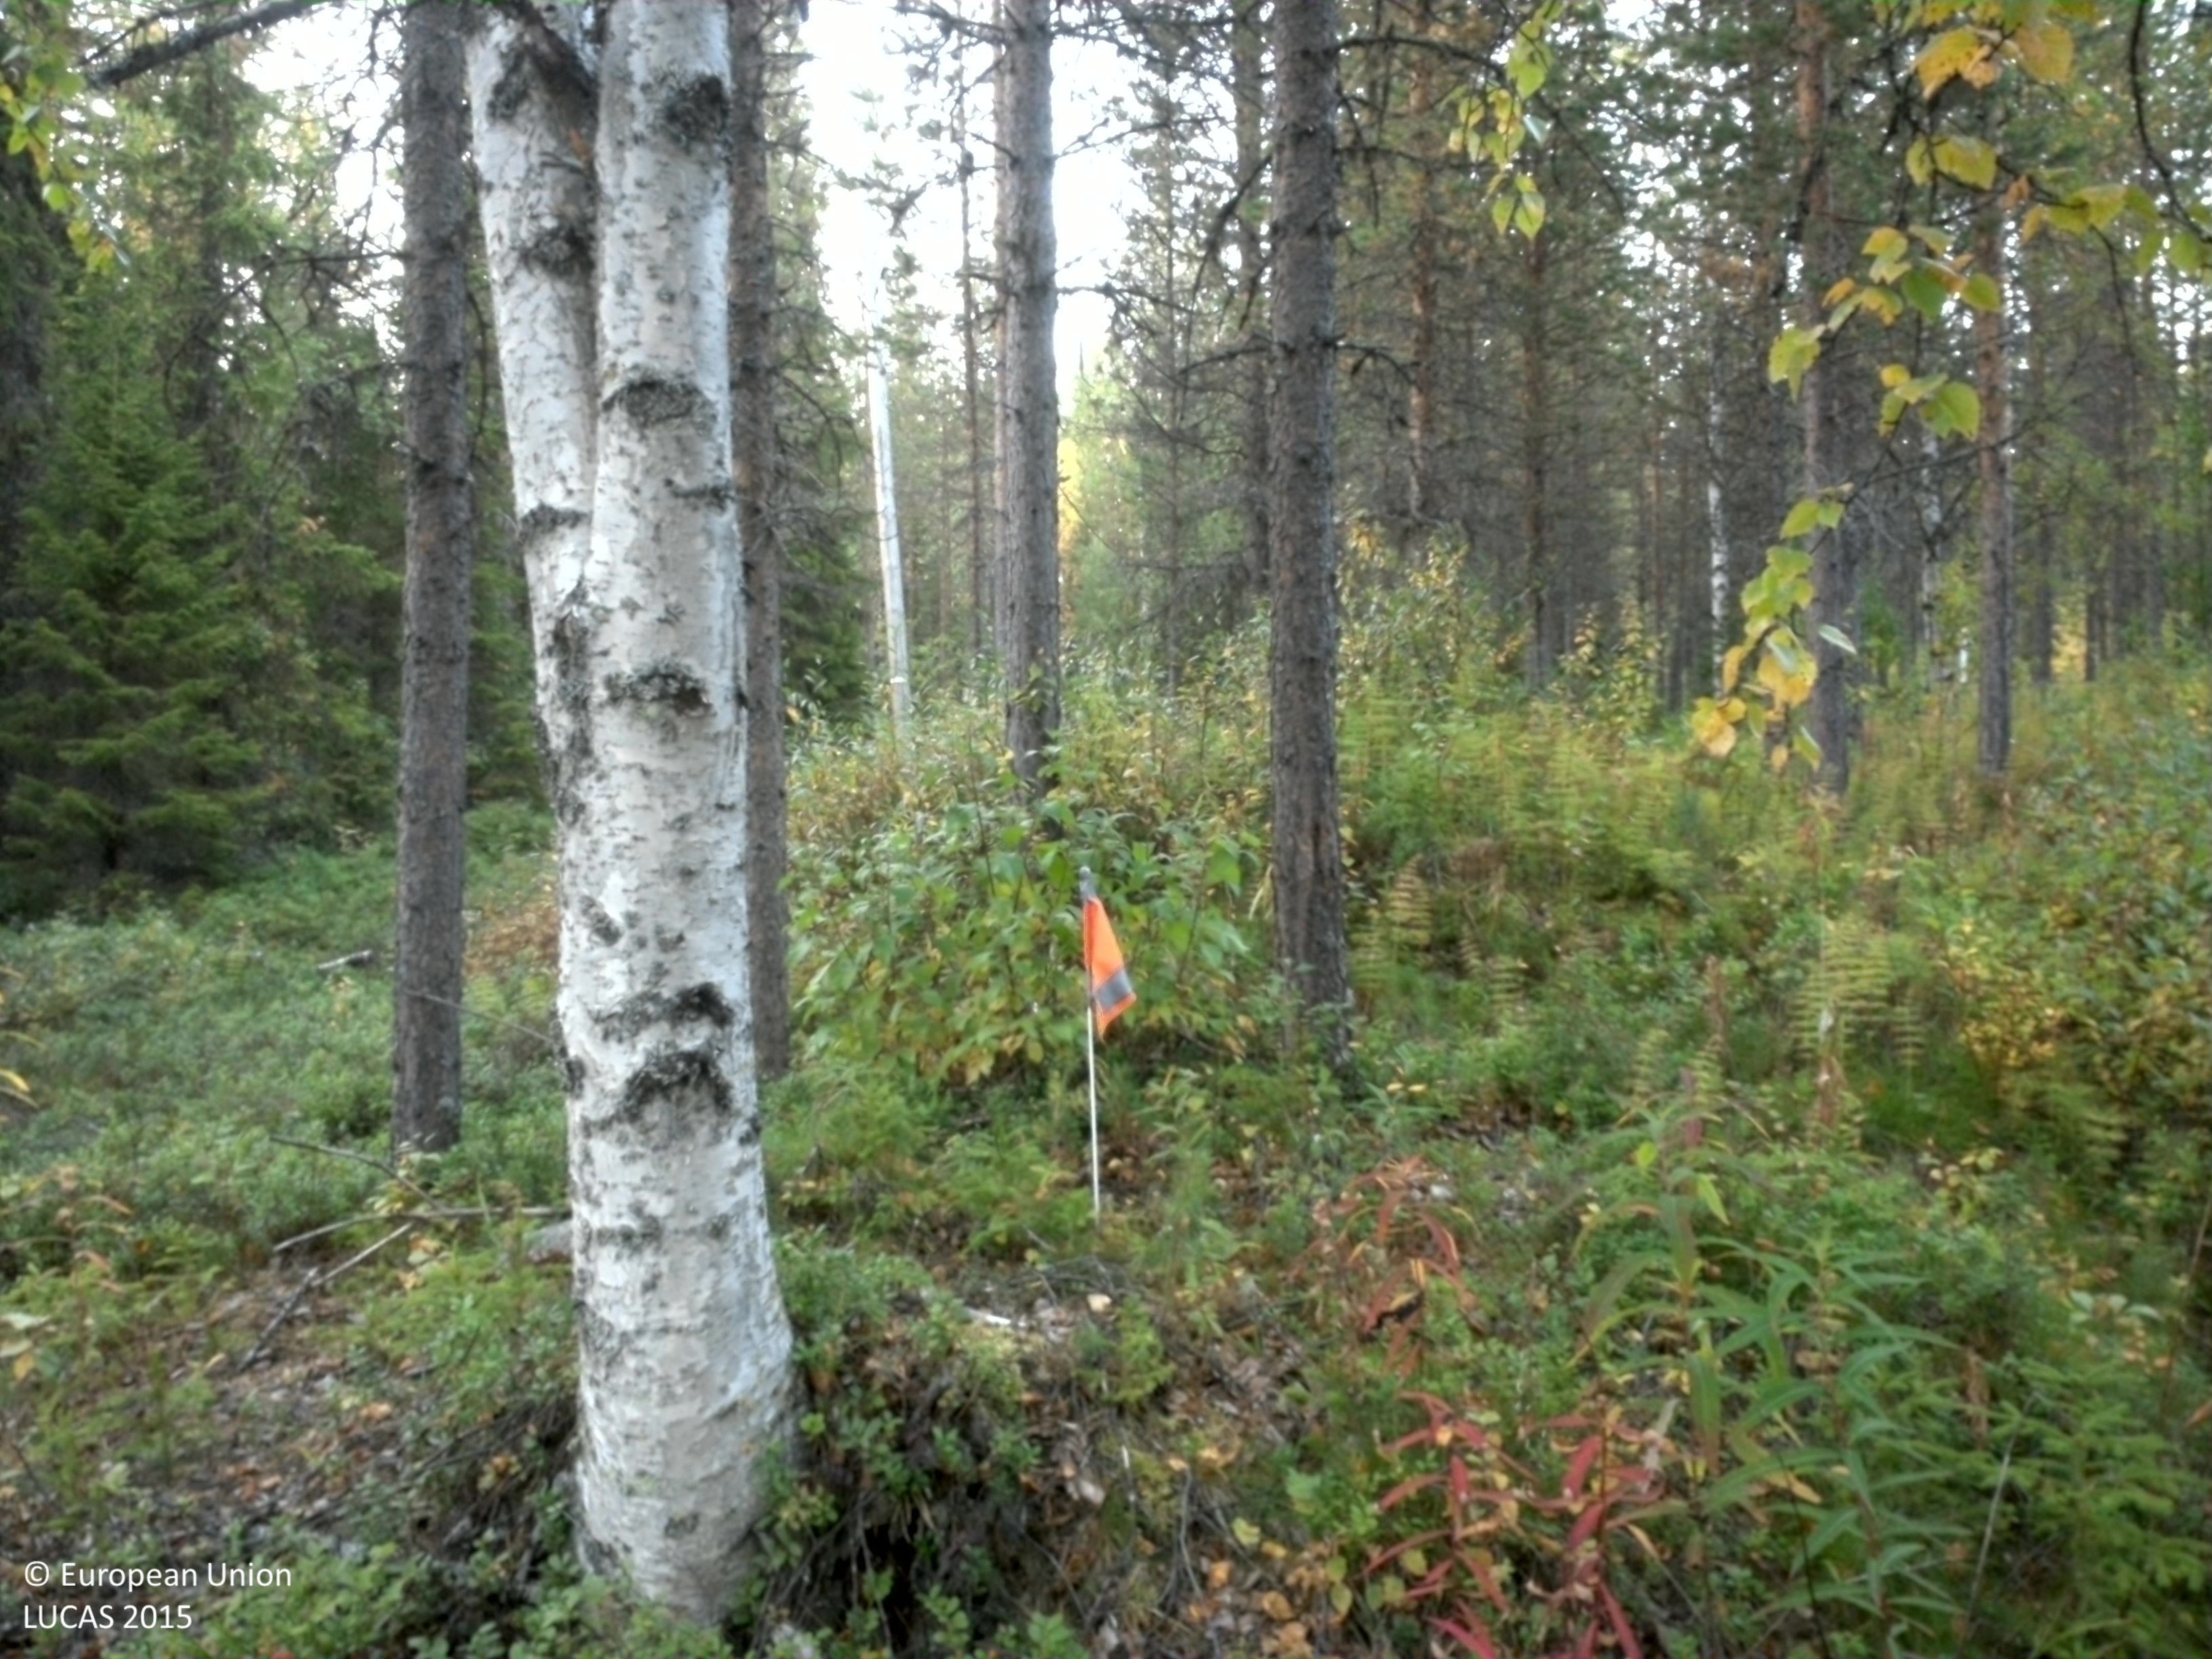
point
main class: Woodland
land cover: Pine dominated coniferous woodland
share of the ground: 25 - 50 %
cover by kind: shrubs 40 %, coniferous forest trees 30 %, herbaceous plants 20 %, broadleaved forest trees 5 %, lichens and mosses 5 %
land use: Forestry
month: September
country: SE
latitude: 65.2684
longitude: 16.7959
